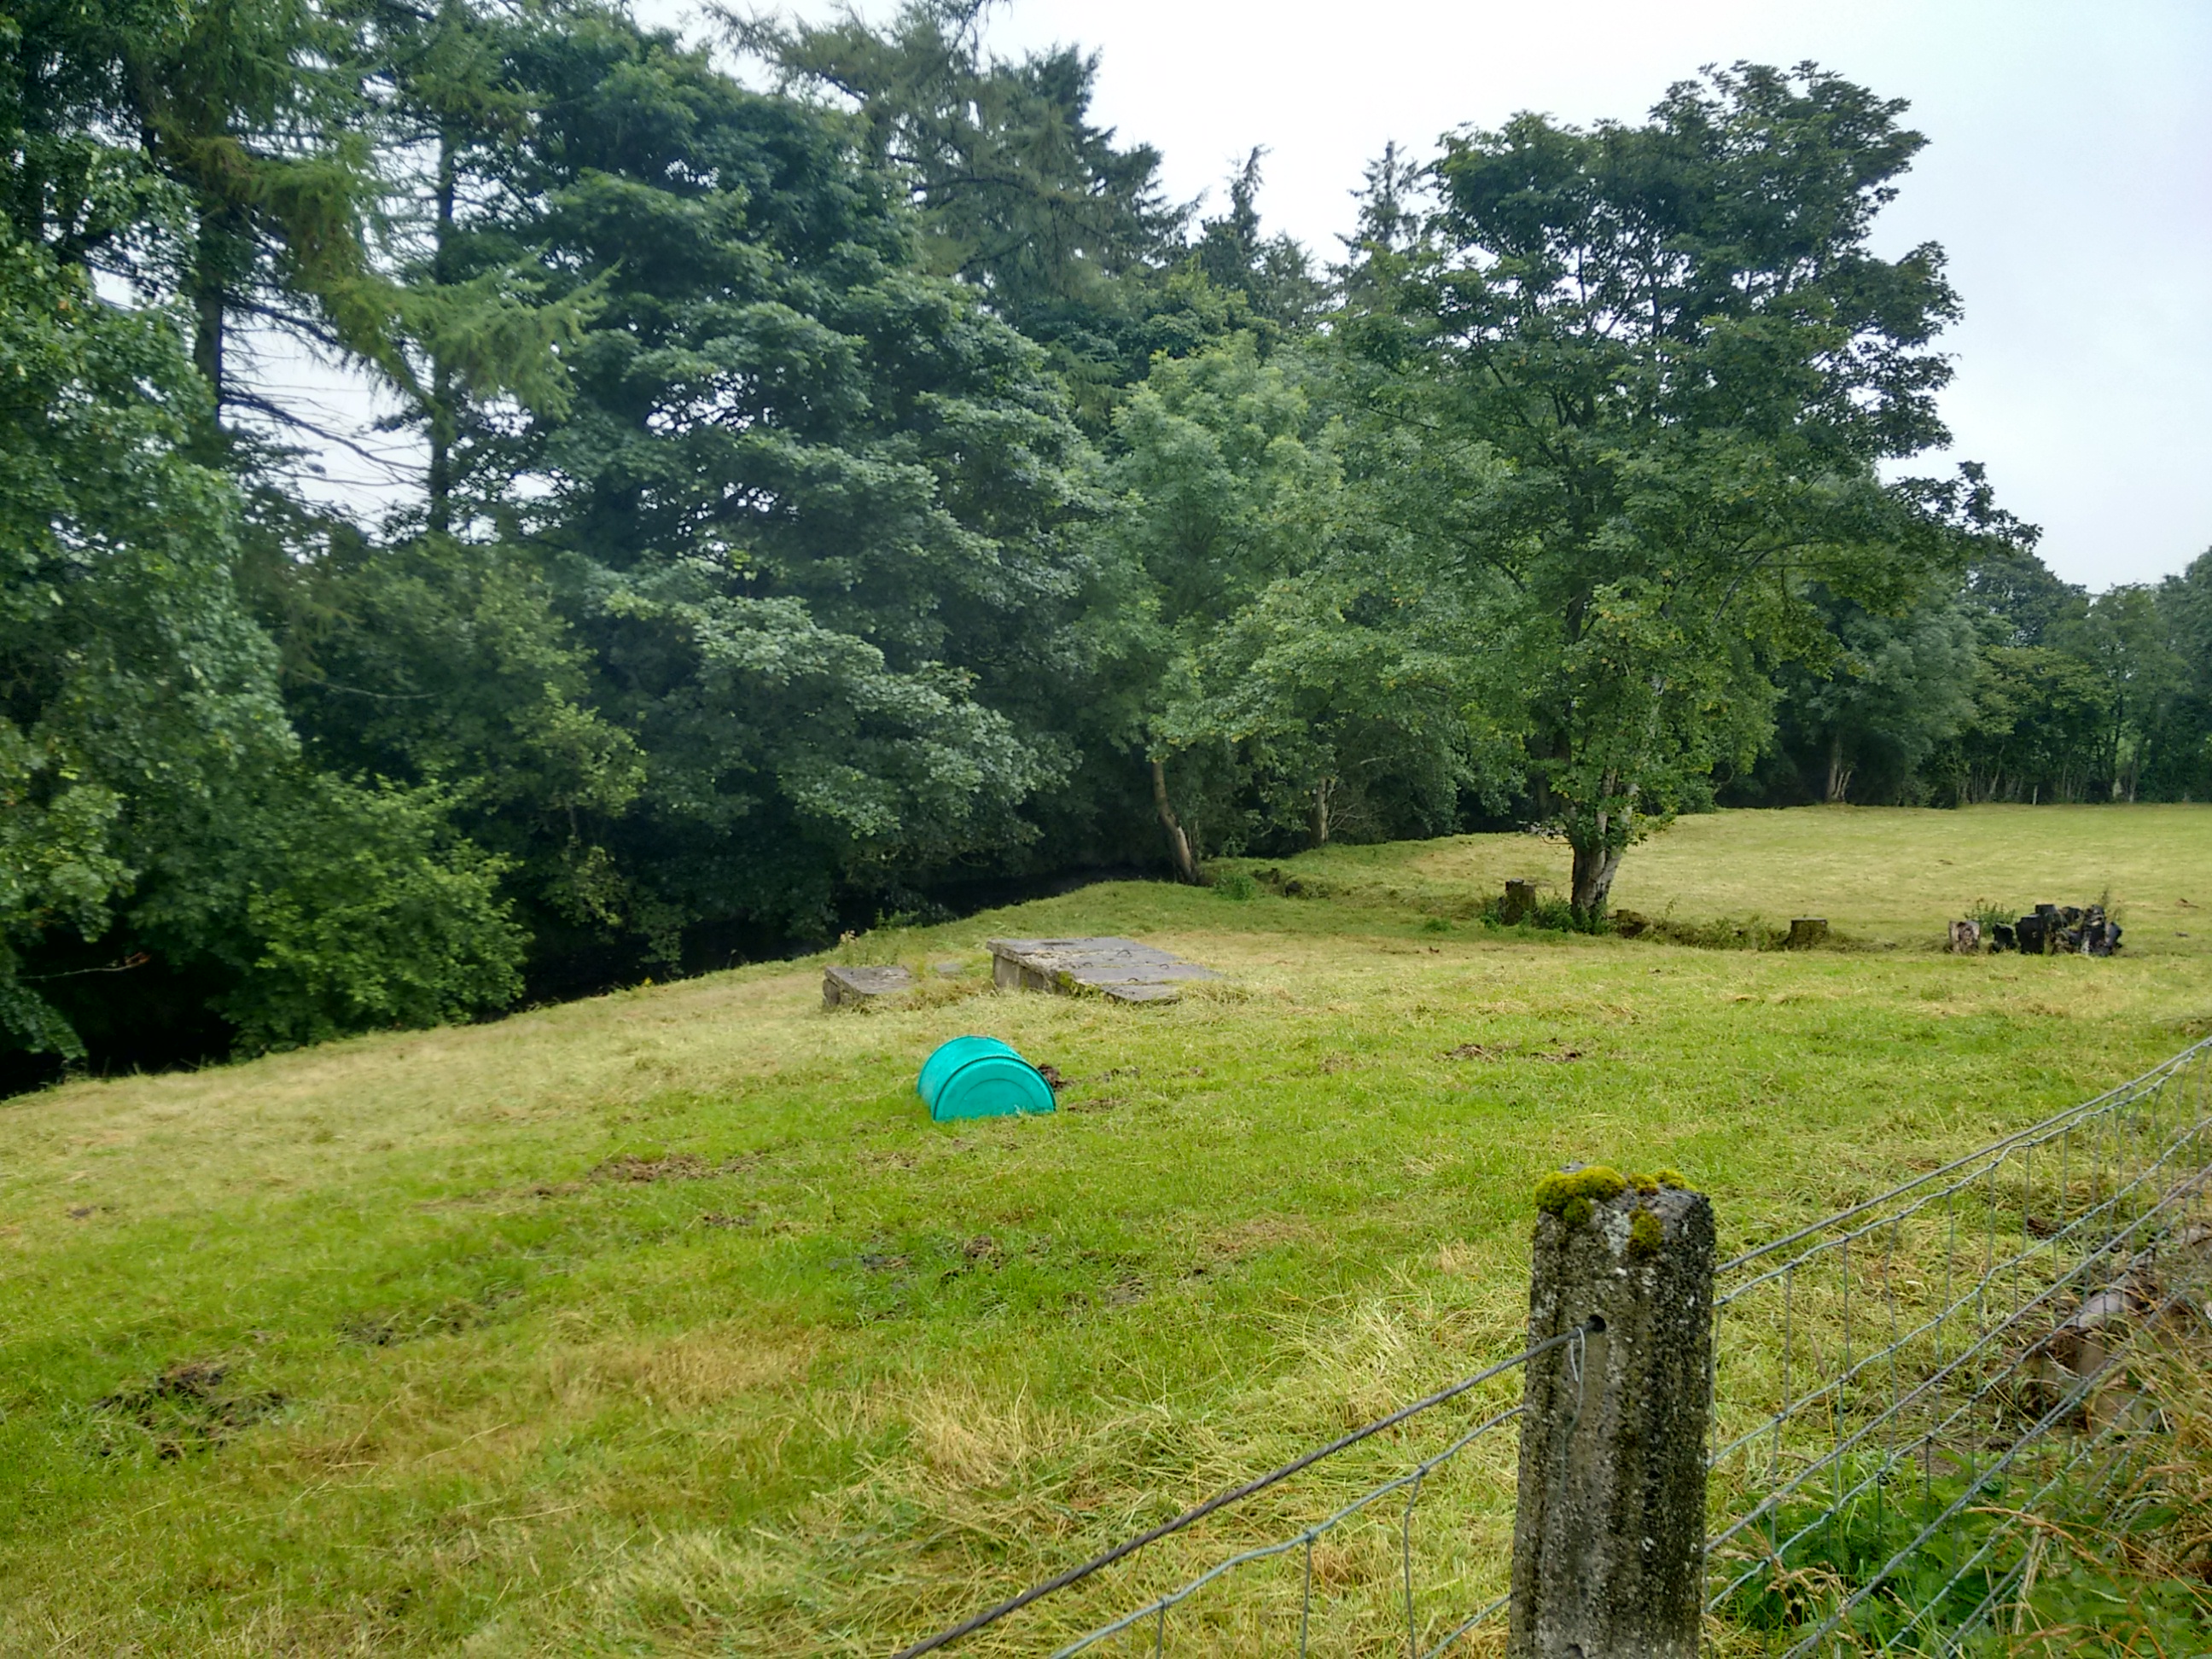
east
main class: Grassland
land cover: Grassland without tree/shrub cover
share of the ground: > 75 %
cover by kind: herbaceous plants 100 %
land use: Agriculture (excluding fallow land and kitchen gardens)
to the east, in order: Grassland without tree/shrub cover; Spruce dominated coniferous woodland; Rivers and streams; Grassland without tree/shrub cover; Fences; Tracks; Fences; Grassland without tree/shrub cover; Spruce dominated coniferous woodland; Rivers and streams; Grassland without tree/shrub cover; Fences; Abandoned hedges; Grassland without tree/shrub cover
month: August
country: GB
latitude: 54.8701
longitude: -6.6289
